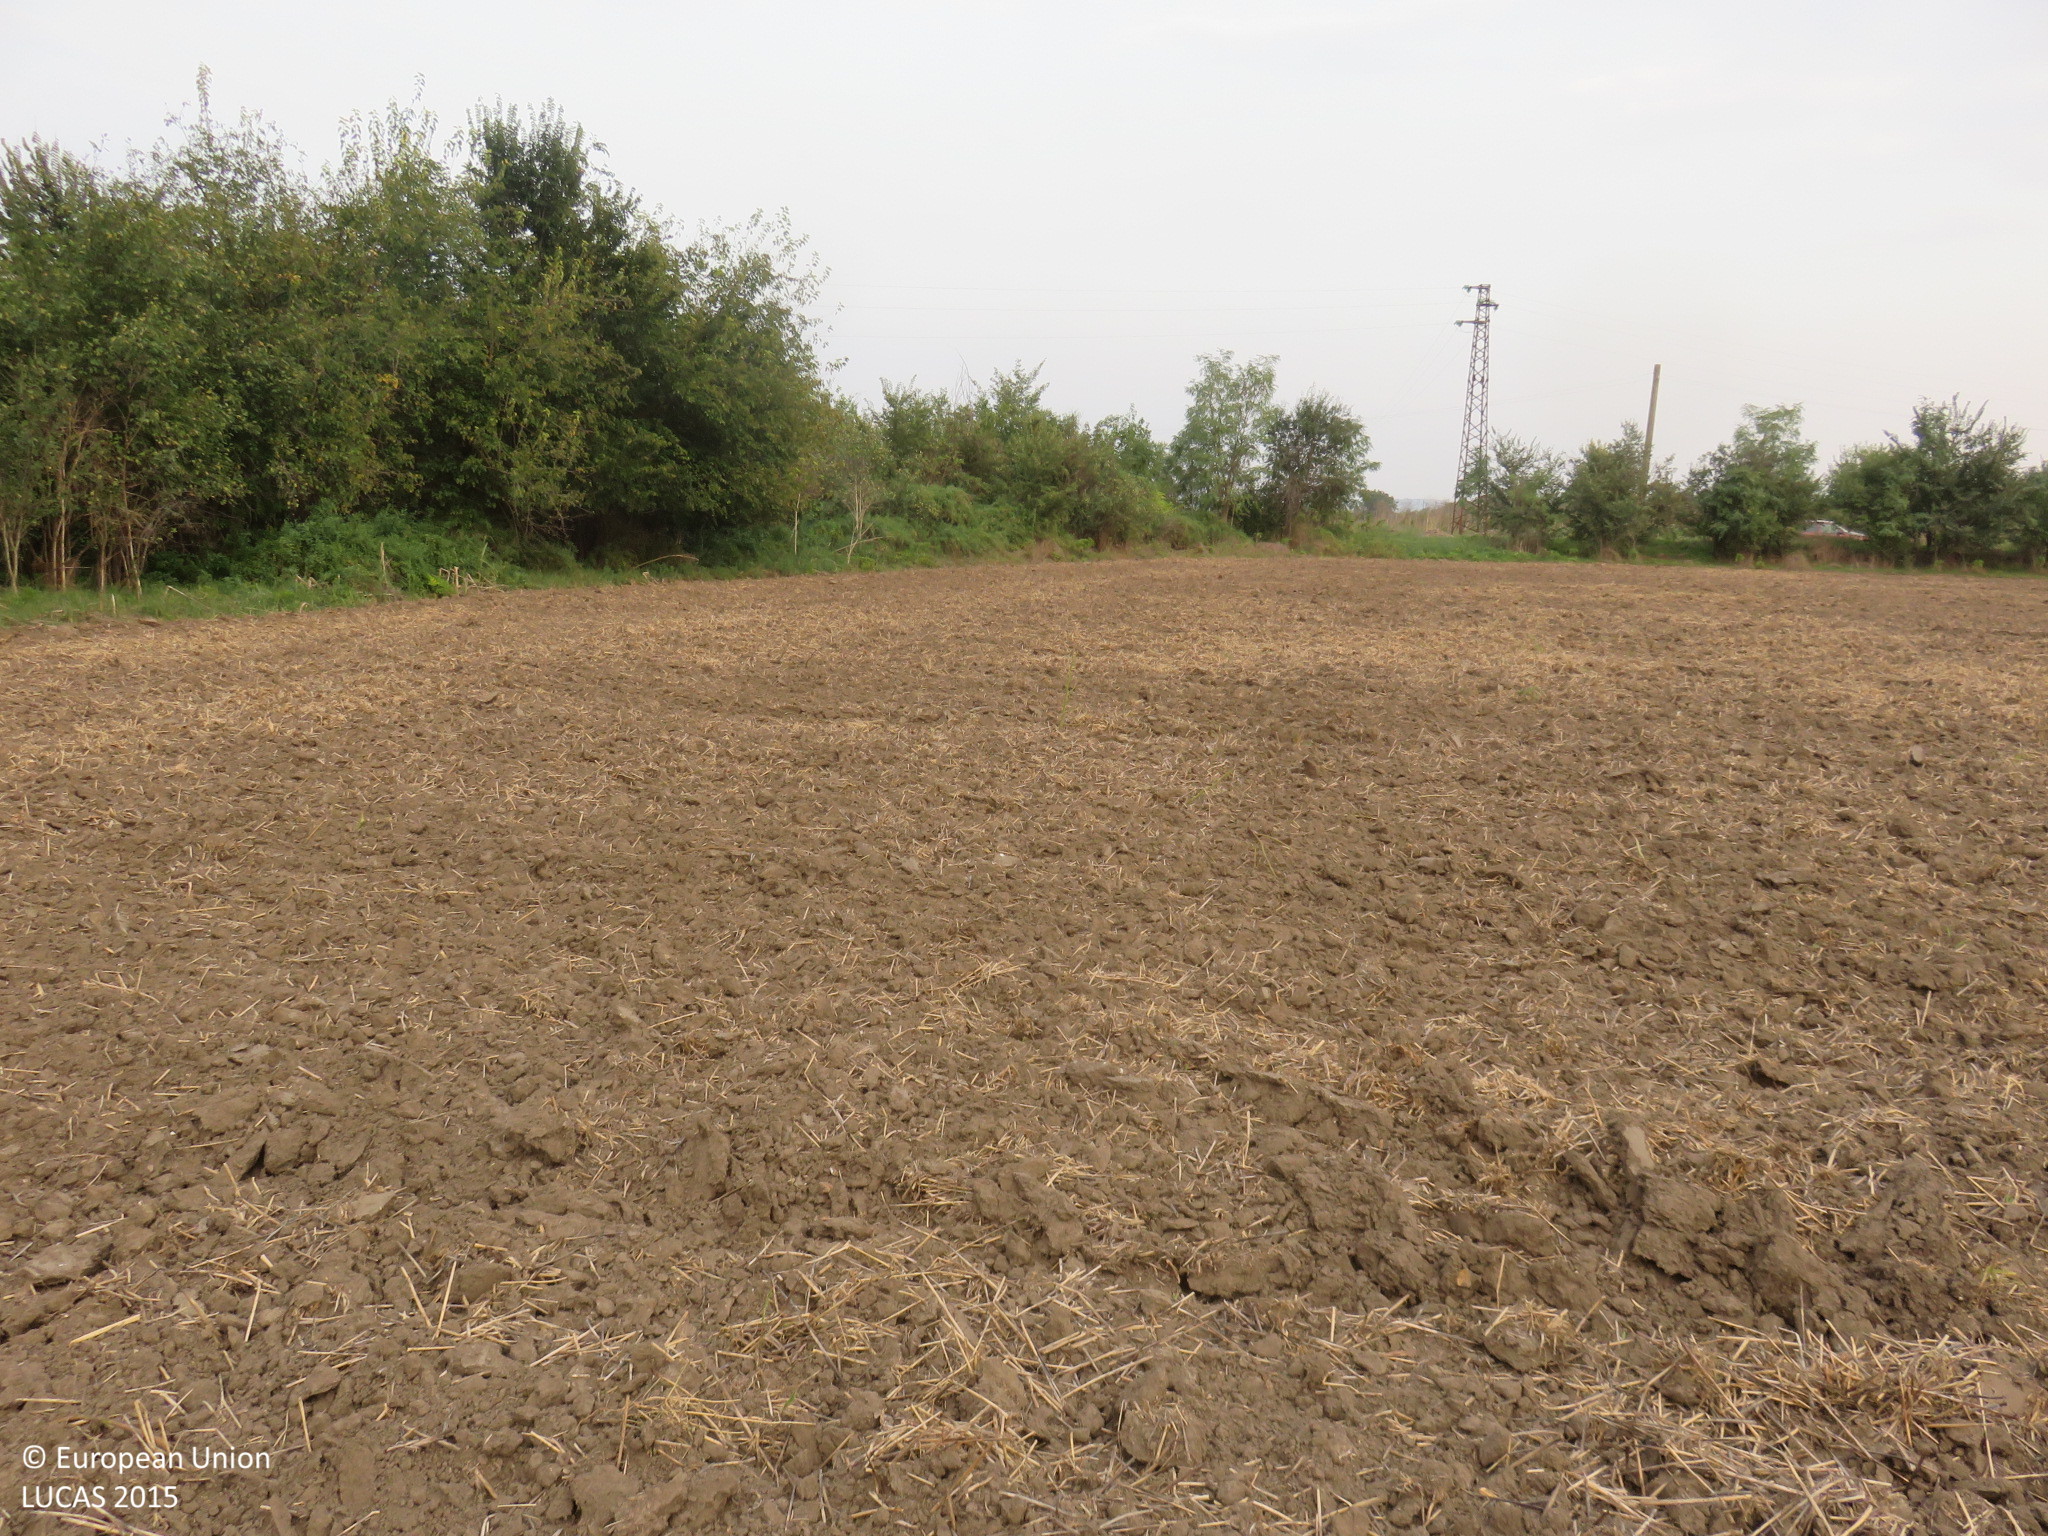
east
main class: Cropland
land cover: Common wheat
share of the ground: 10 - 25 %
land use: Agriculture (excluding fallow land and kitchen gardens)
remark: Harvested field
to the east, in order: Common wheat; Shrubland with sparse tree cover; Broadleaved woodland; Electric lines; Broadleaved woodland; Electric lines; Broadleaved woodland; Grass margins; Tracks; Grassland without tree/shrub cover; Grassland with sparse tree/shrub cover; Sunflower
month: September
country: BG
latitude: 43.5553
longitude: 24.9374
